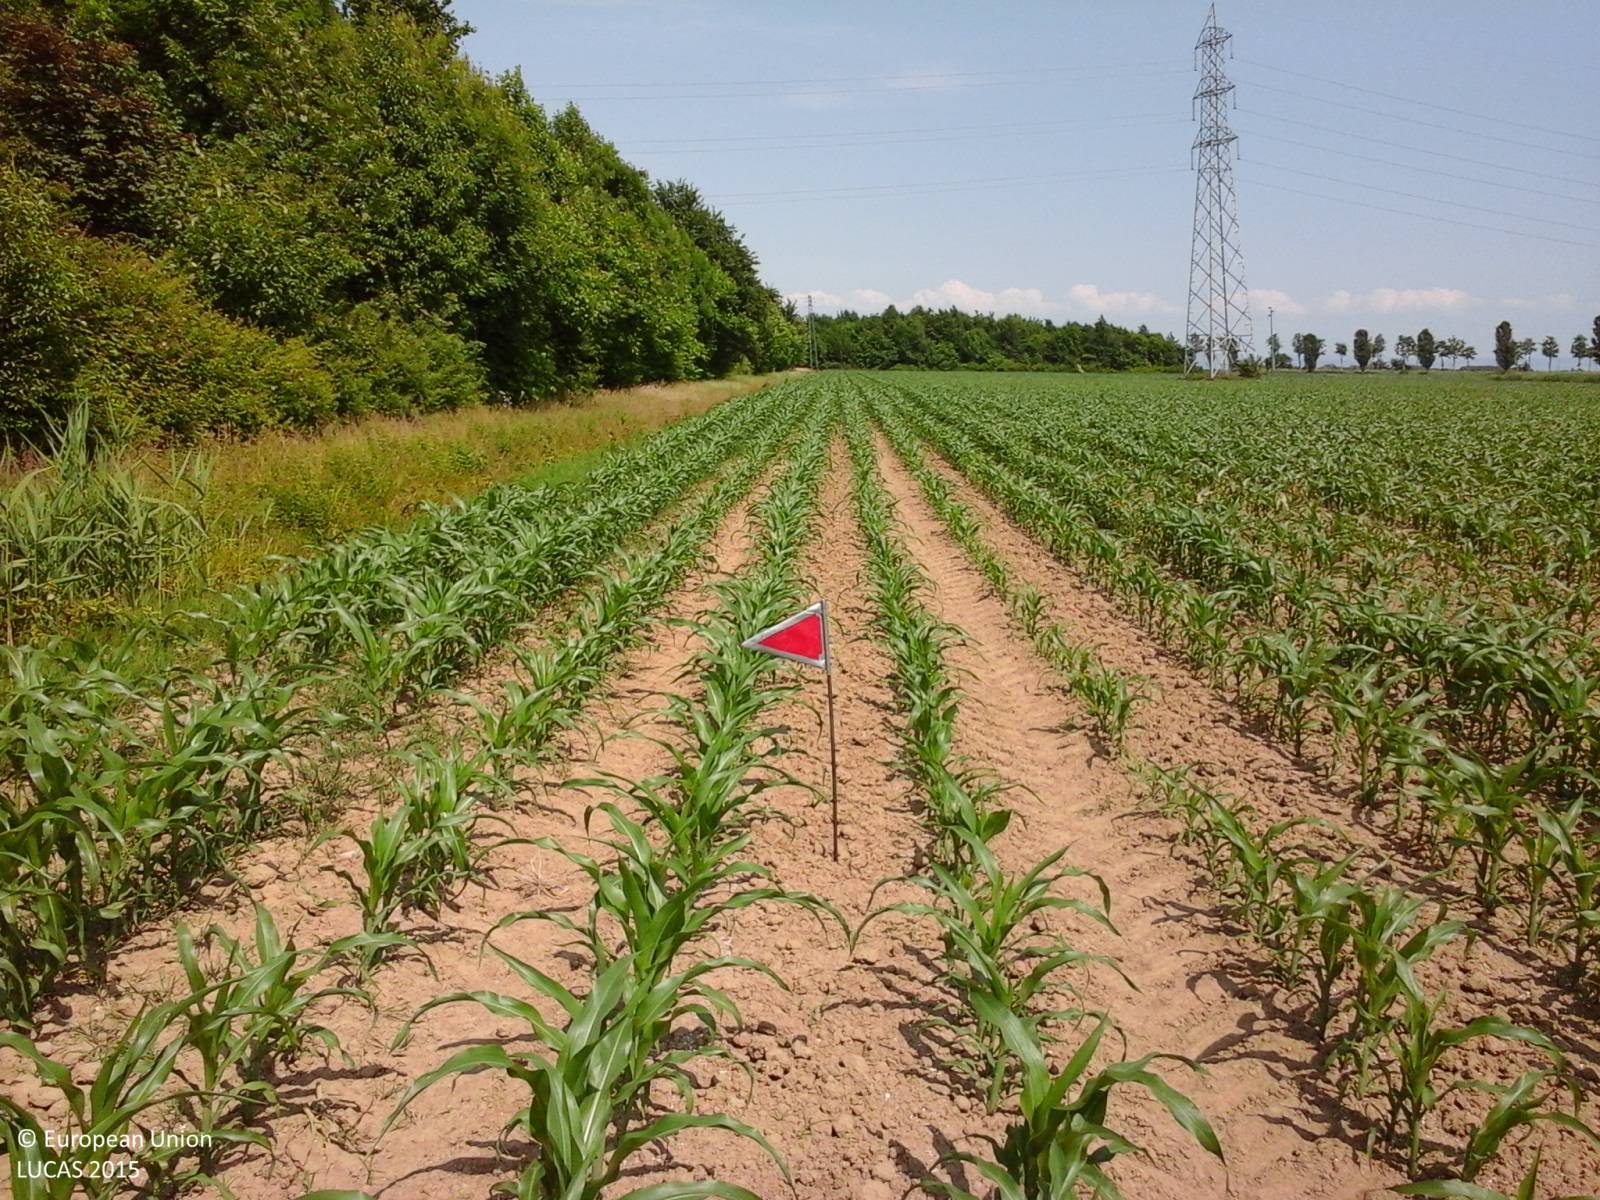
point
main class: Cropland
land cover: Maize
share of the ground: 50 - 75 %
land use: Agriculture (excluding fallow land and kitchen gardens)
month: May
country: IT
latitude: 45.7390
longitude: 13.3760
